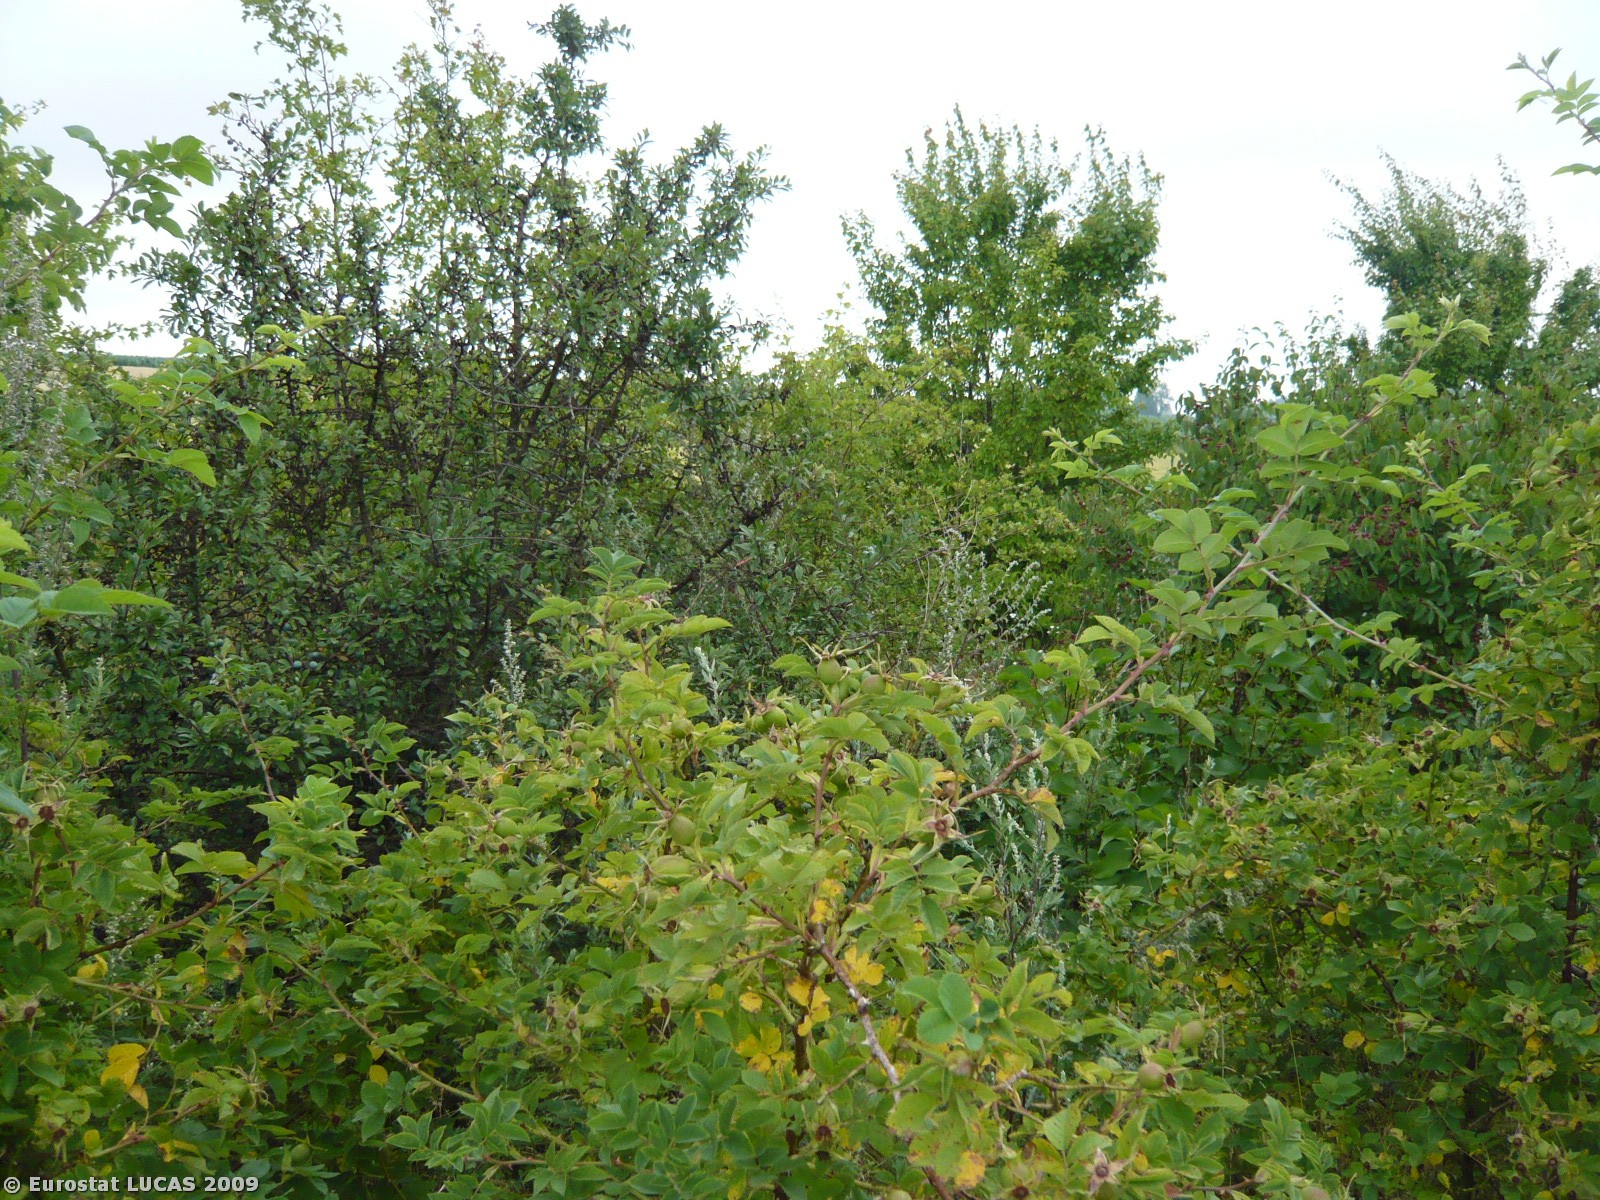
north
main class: Grassland
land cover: Grassland without tree/shrub cover
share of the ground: > 75 %
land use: Agriculture (excluding fallow land and kitchen gardens)
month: July
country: DK
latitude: 55.7767
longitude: 11.9910
